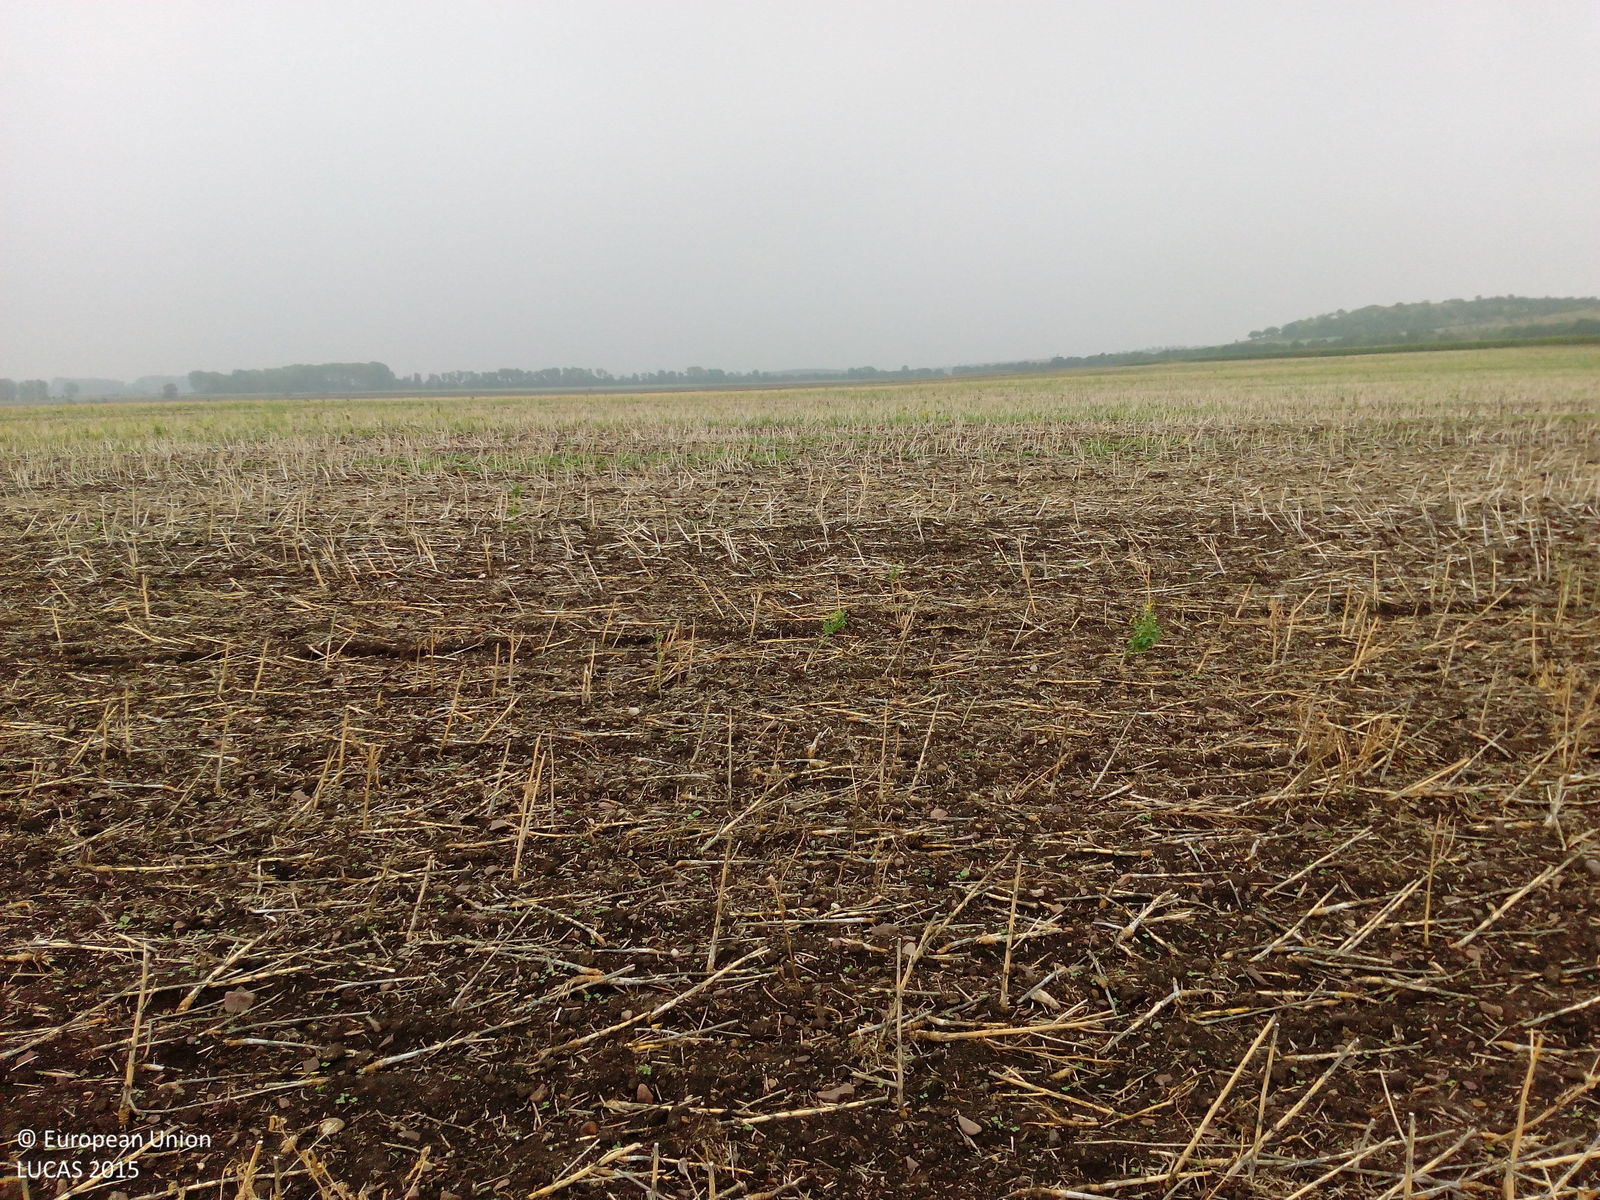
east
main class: Cropland
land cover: Rape and turnip rape
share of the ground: < 10 %
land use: Agriculture (excluding fallow land and kitchen gardens)
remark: Harvested field
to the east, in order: Rape and turnip rape
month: August
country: DE
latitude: 51.0603
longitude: 11.0698
